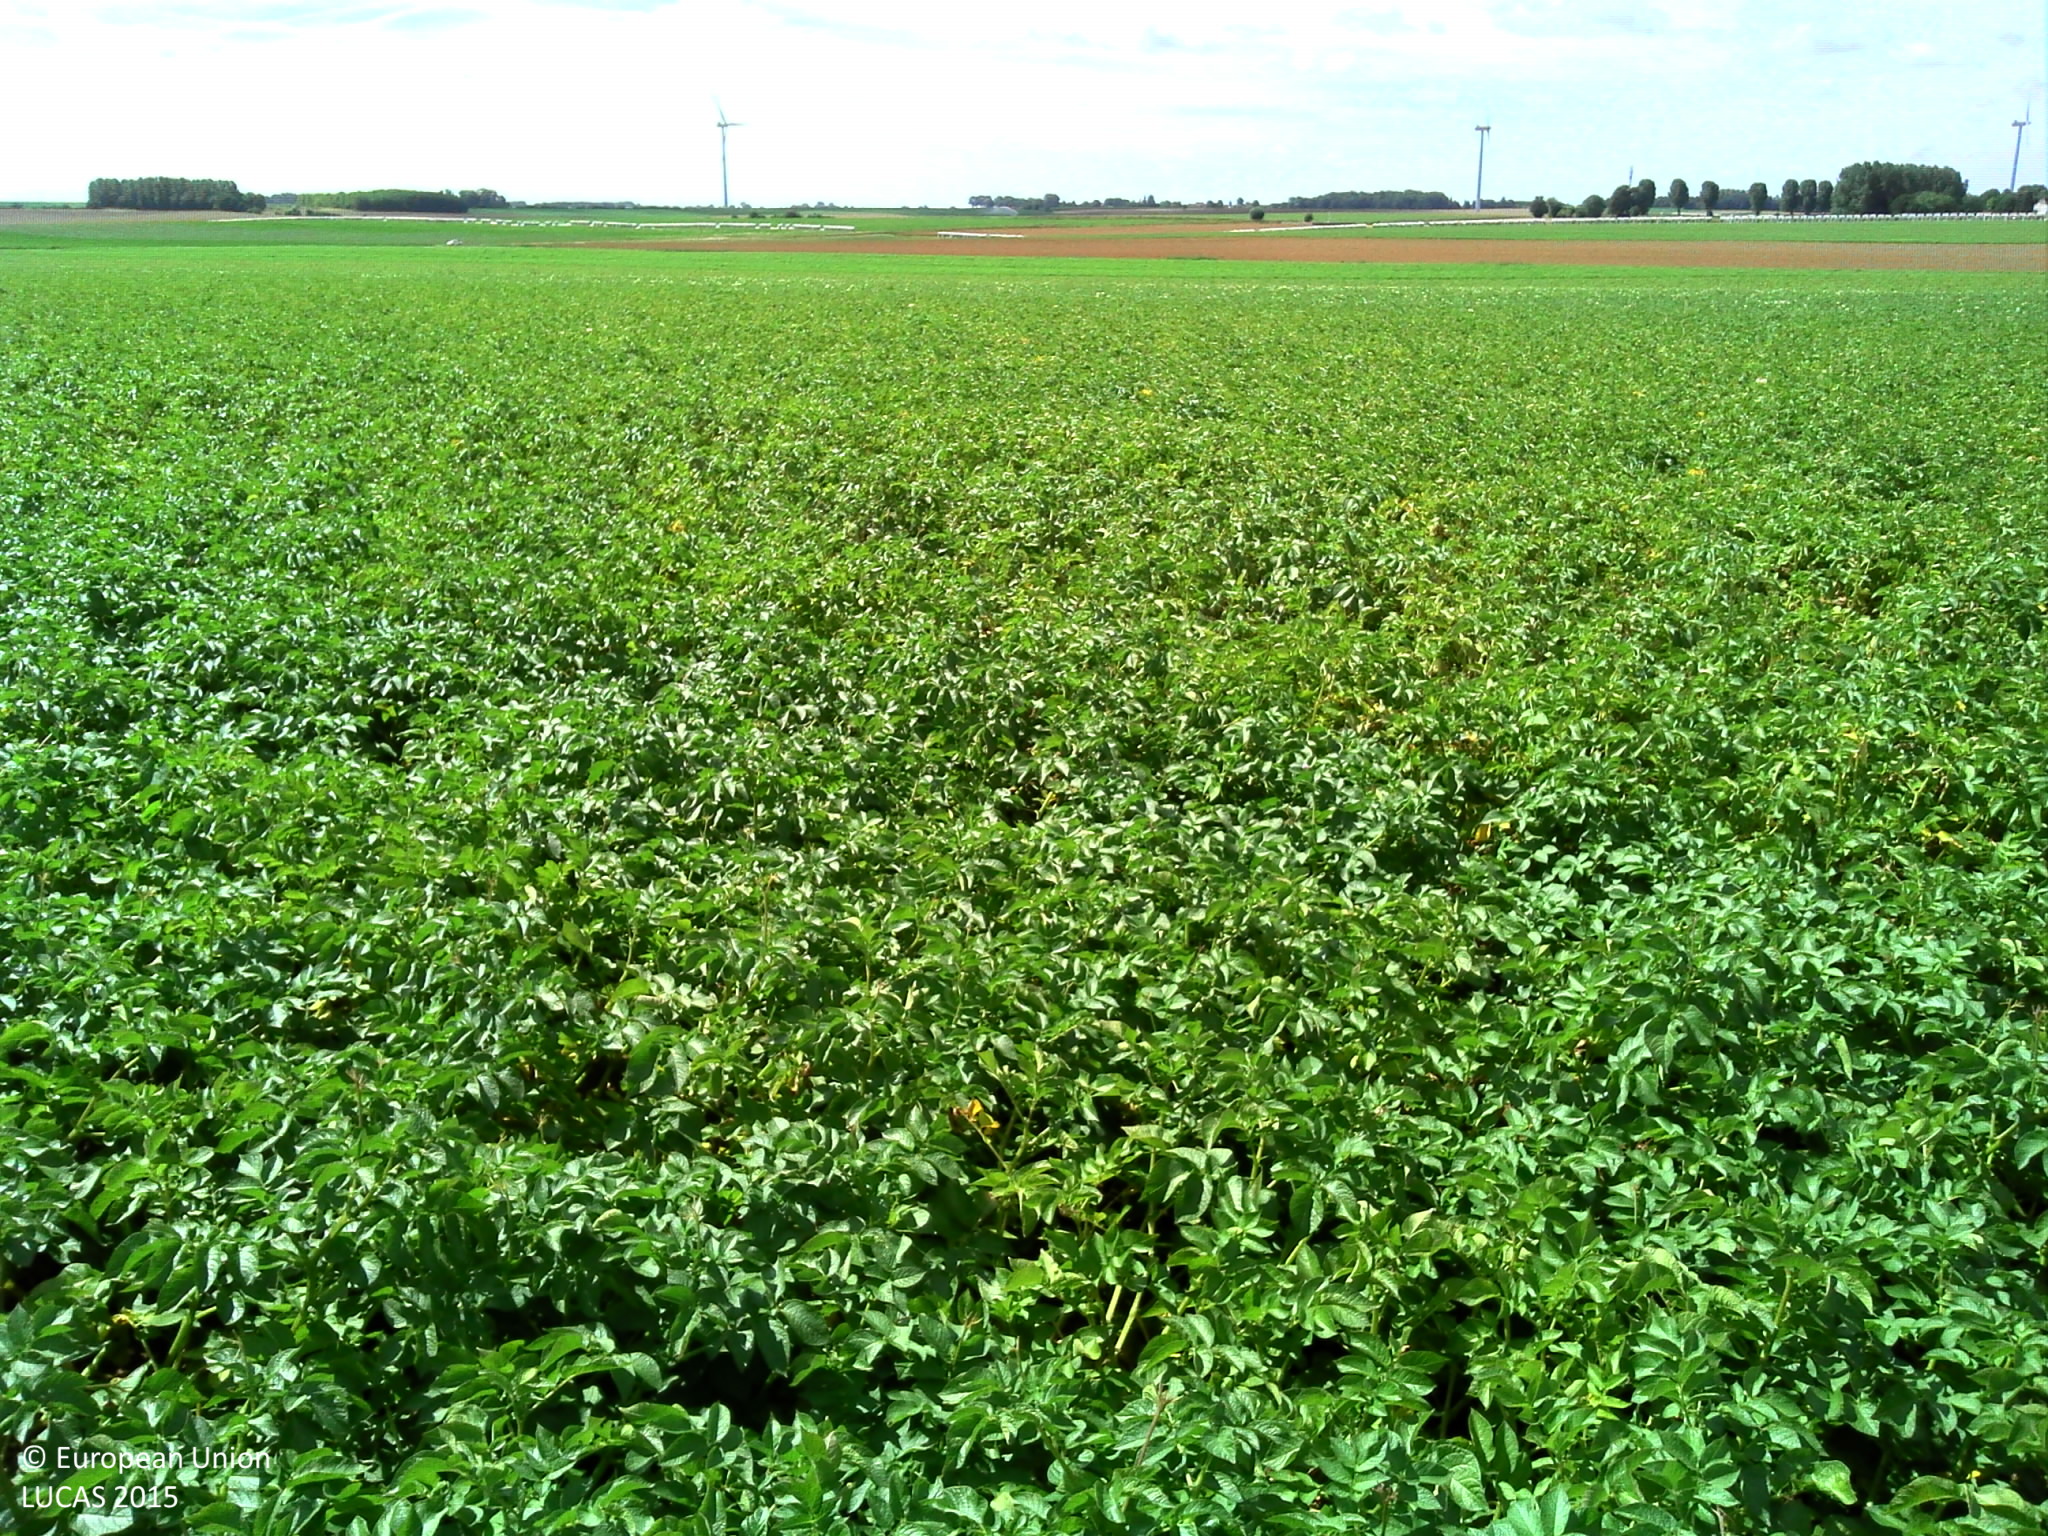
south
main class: Cropland
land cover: Potatoes
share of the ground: > 75 %
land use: Agriculture (excluding fallow land and kitchen gardens)
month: July
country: FR
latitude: 50.1557
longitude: 2.8090
